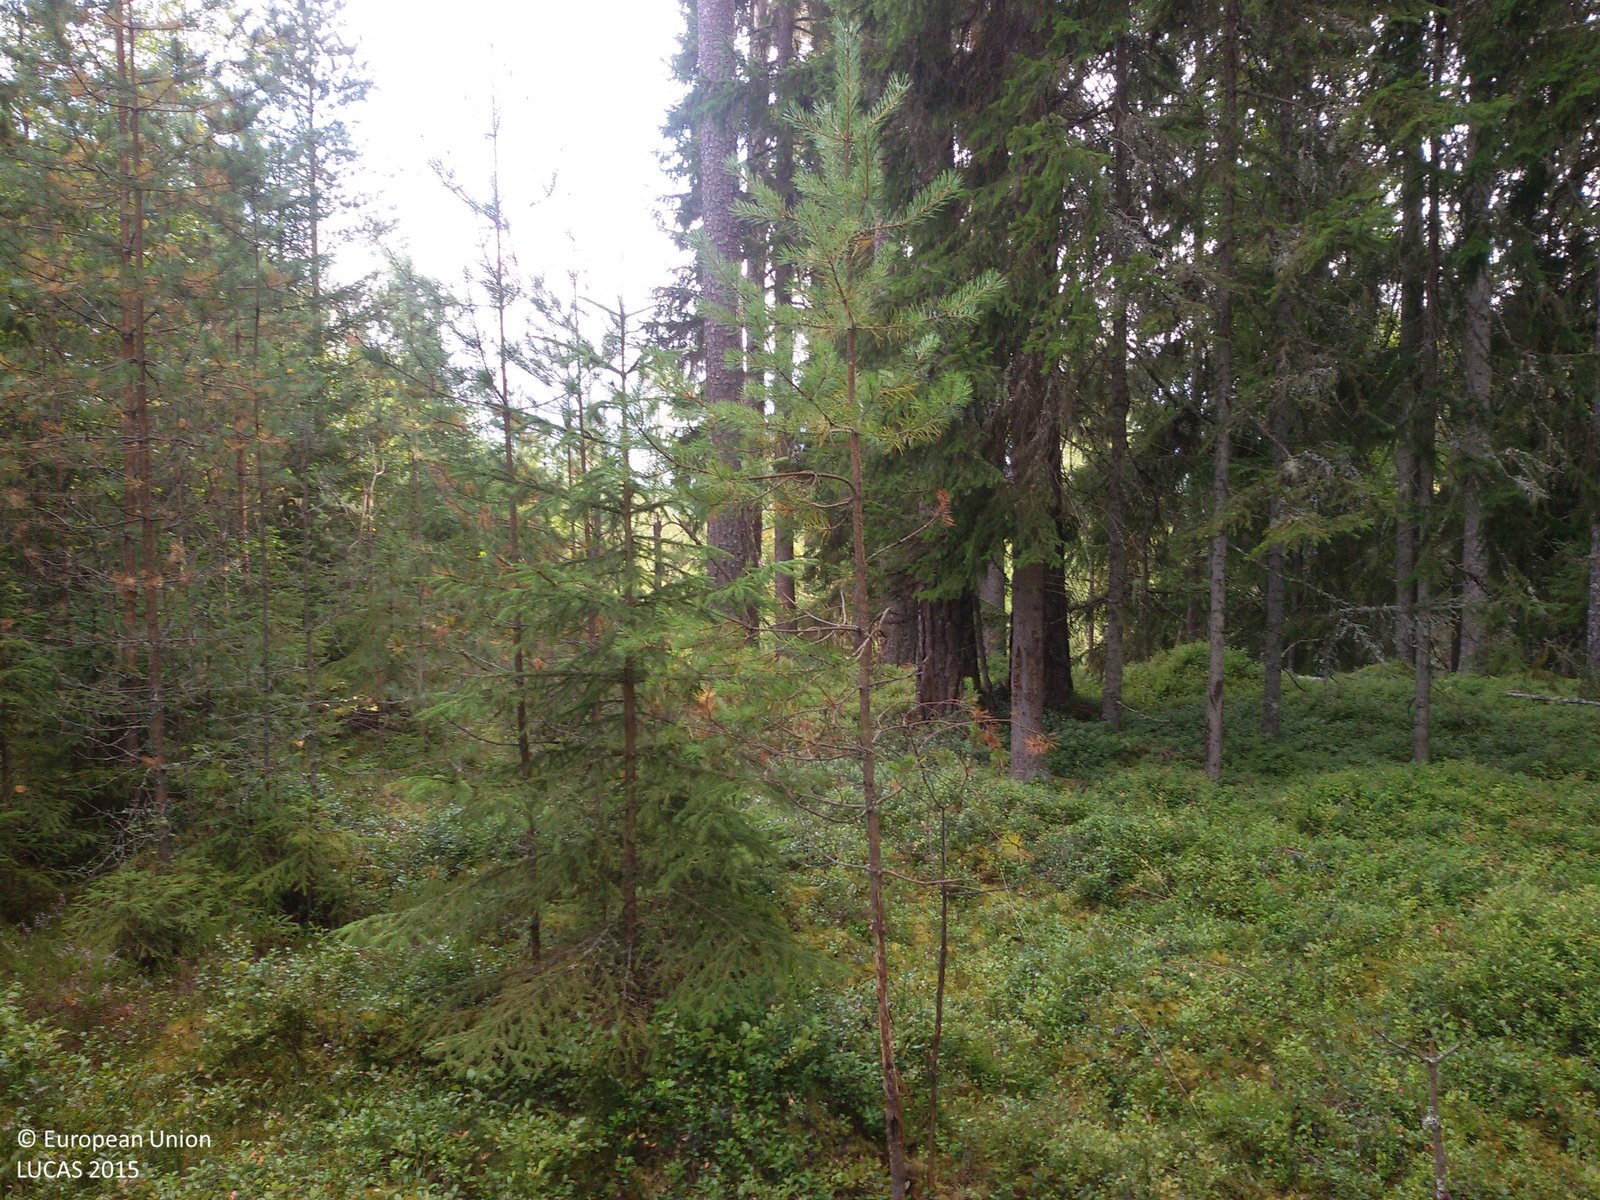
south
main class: Woodland
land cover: Pine dominated coniferous woodland
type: boreal forest
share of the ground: 50 - 75 %
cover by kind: coniferous forest trees 60 %, shrubs 20 %, broadleaved forest trees 10 %, herbaceous plants 5 %, lichens and mosses 5 %
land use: Forestry
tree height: > 5 m
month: September
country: SE
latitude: 60.7287
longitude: 15.3590
